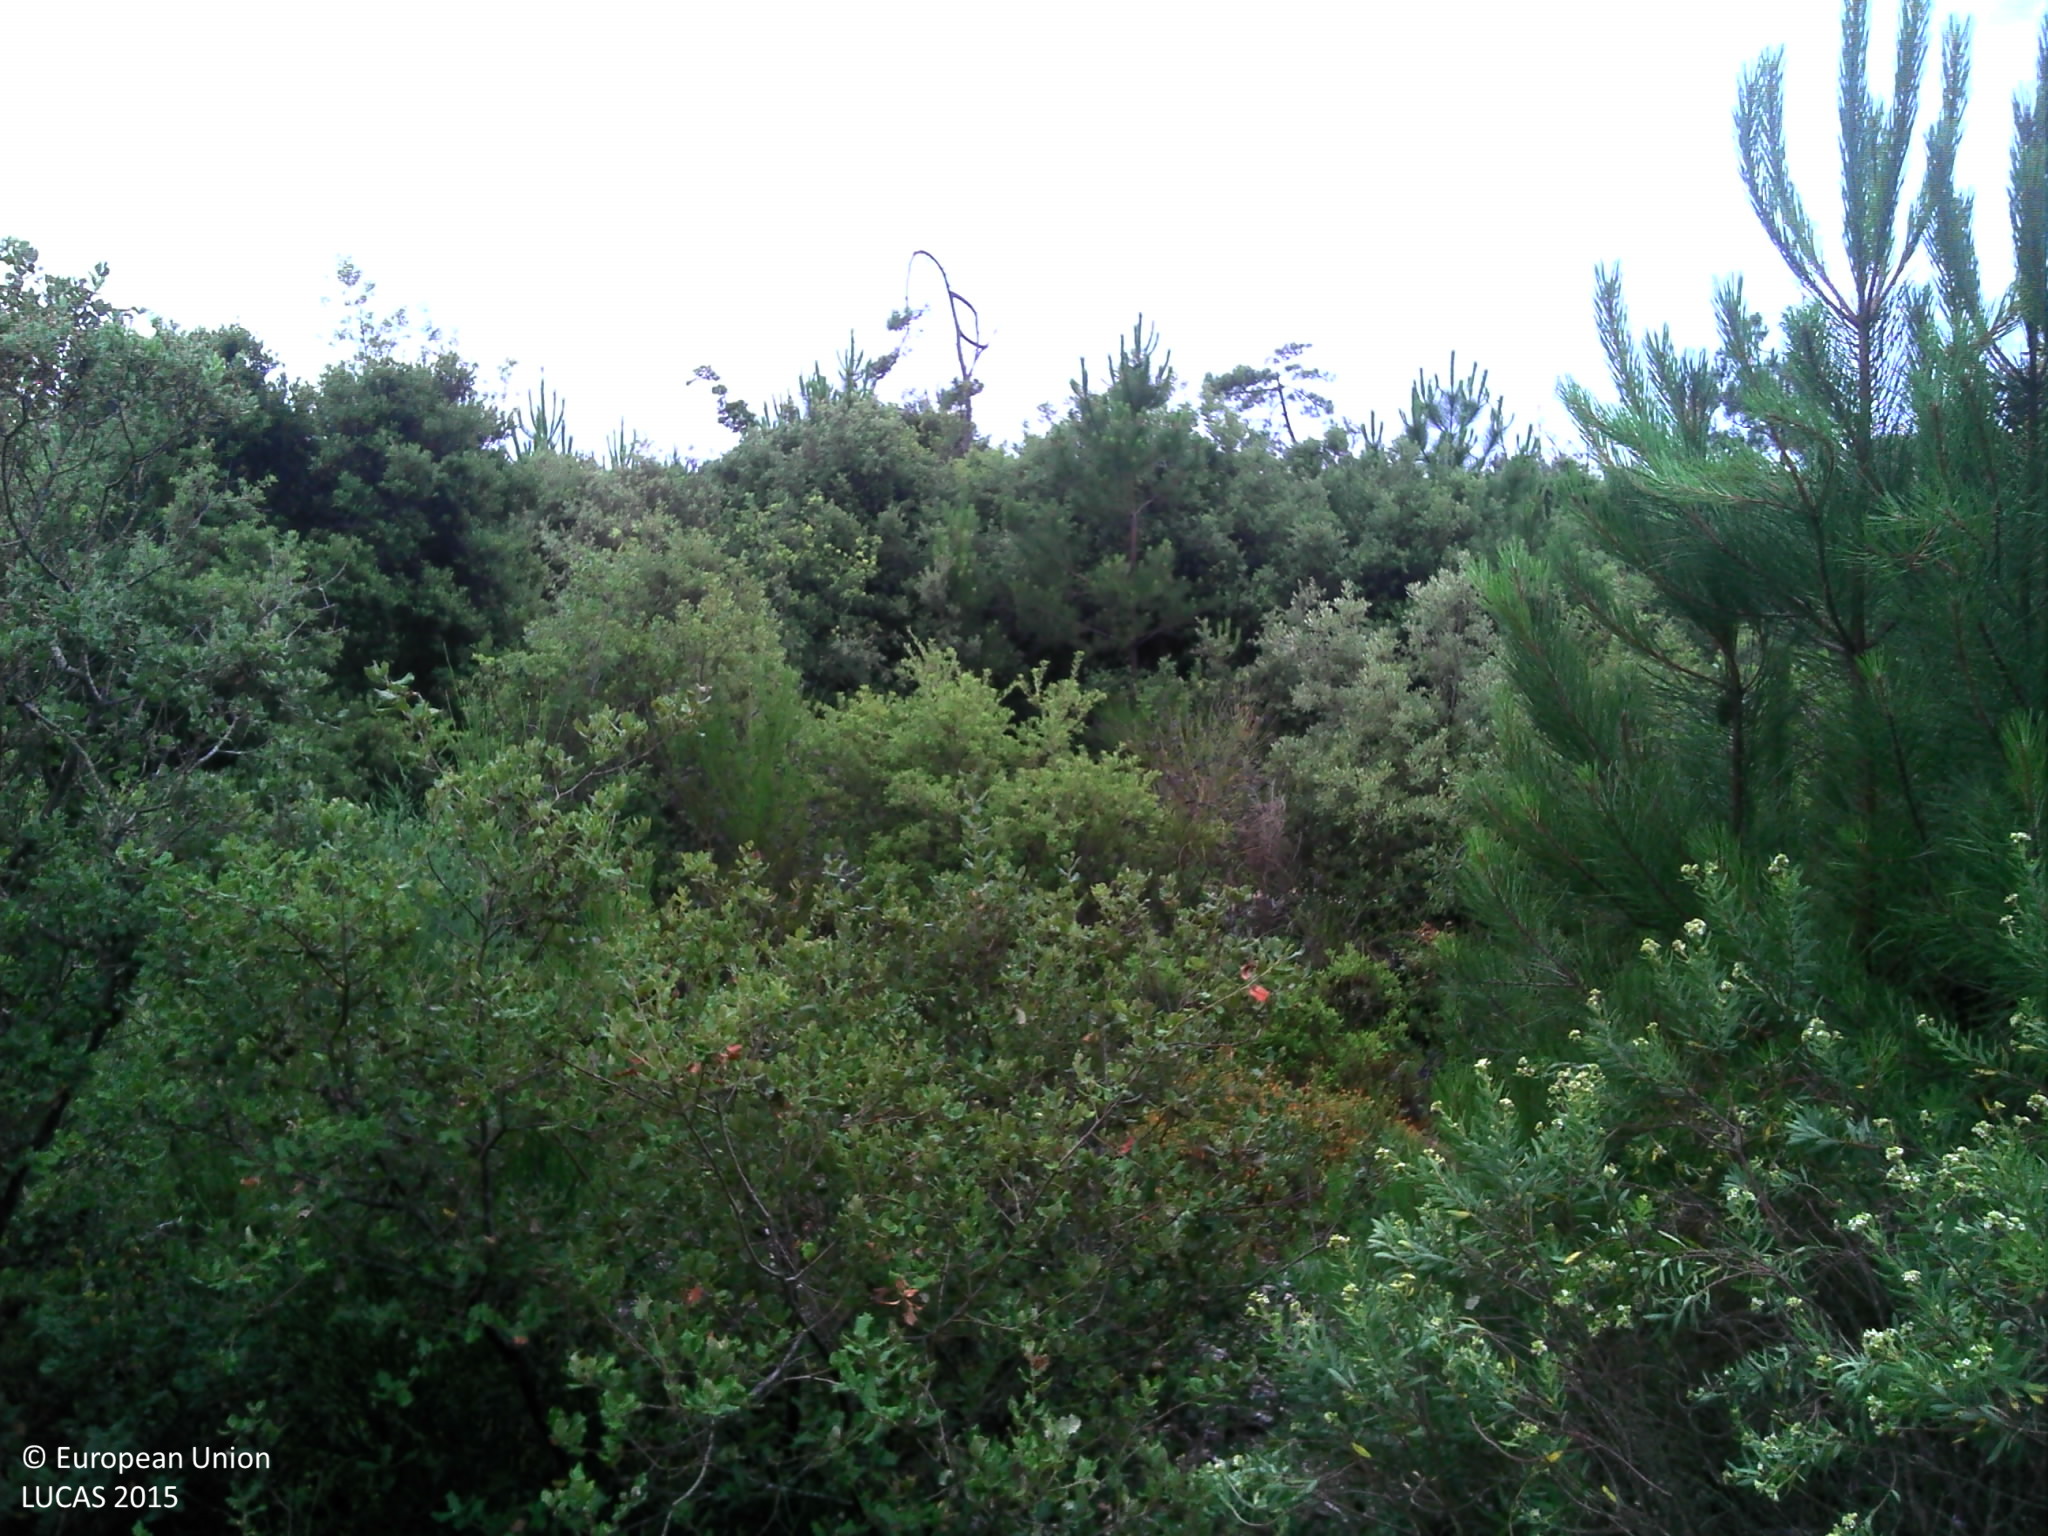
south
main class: Woodland
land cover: Pine dominated mixed woodland
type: coniferous forest of the mediterranean region
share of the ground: > 75 %
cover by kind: coniferous forest trees 75 %, broadleaved forest trees 25 %
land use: Forestry
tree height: > 5 m
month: June
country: FR
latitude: 45.6593
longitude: -1.1303
